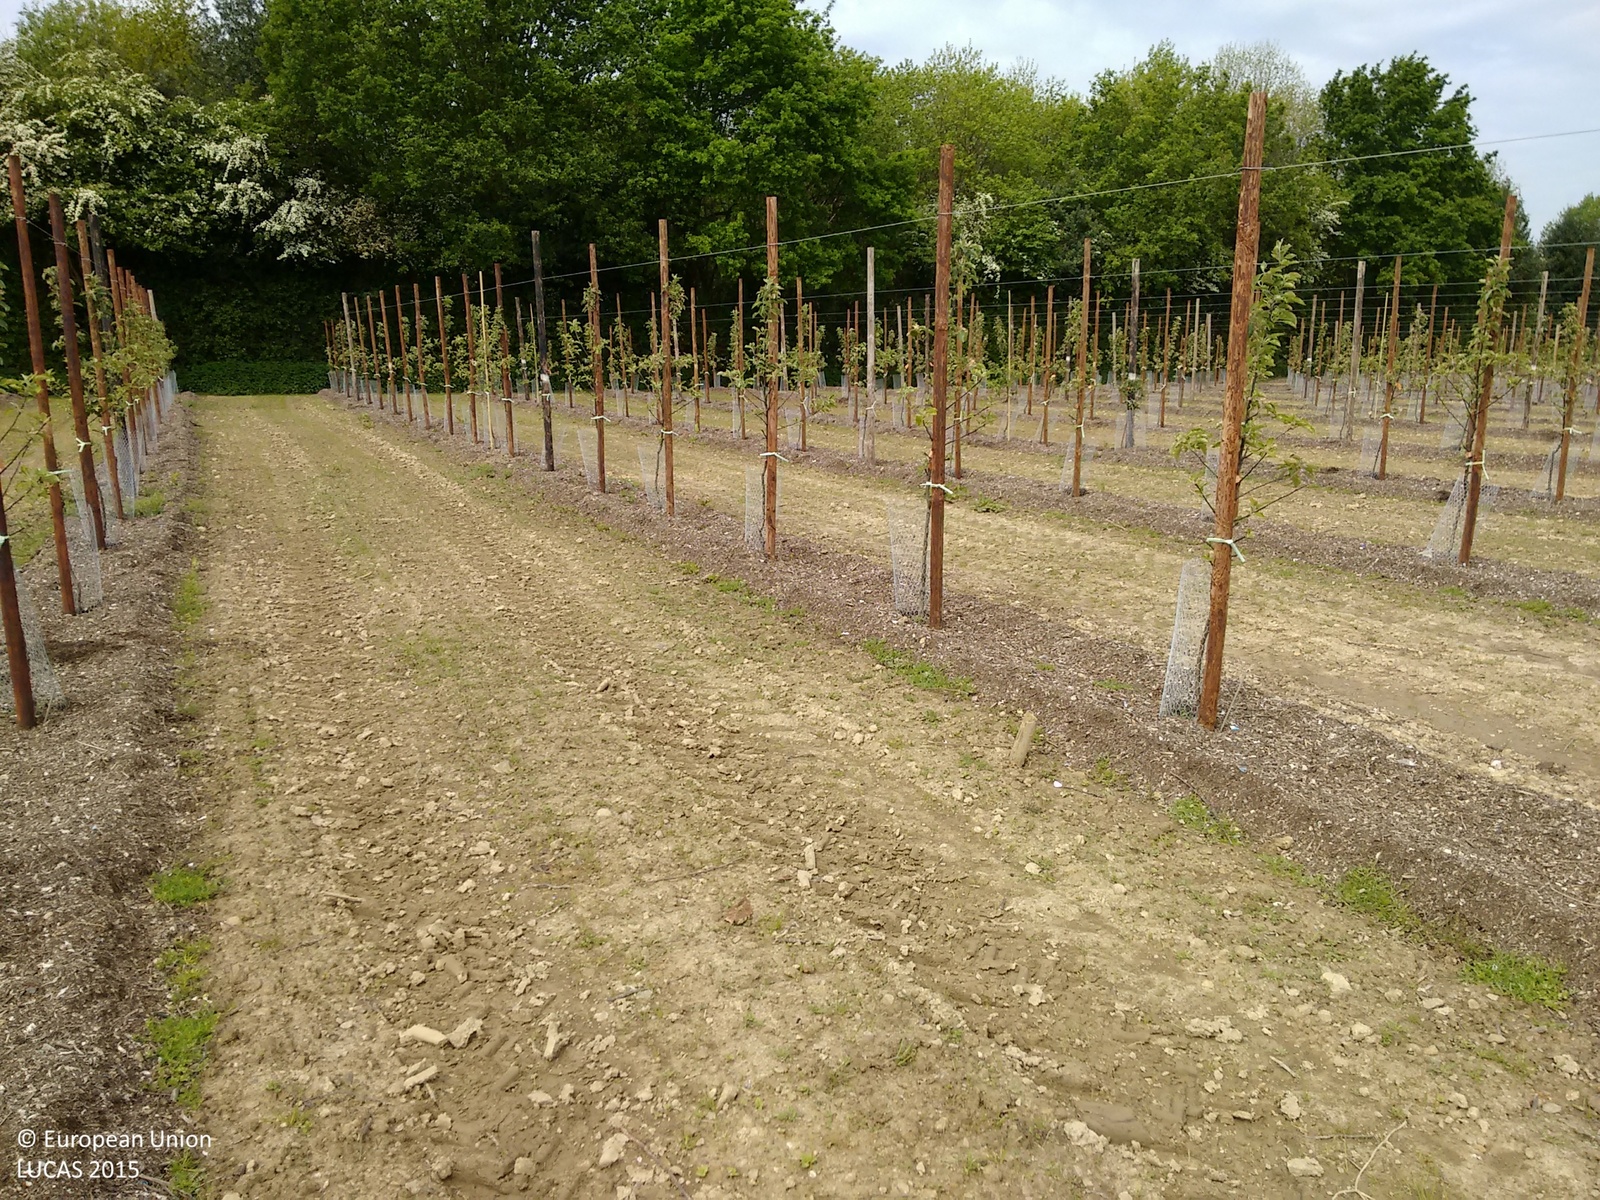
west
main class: Cropland
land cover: Apple fruit
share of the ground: < 10 %
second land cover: Spontaneously vegetated surfaces
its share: < 10 %
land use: Agriculture (excluding fallow land and kitchen gardens)
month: May
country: GB
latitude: 51.1504
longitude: 0.3494
